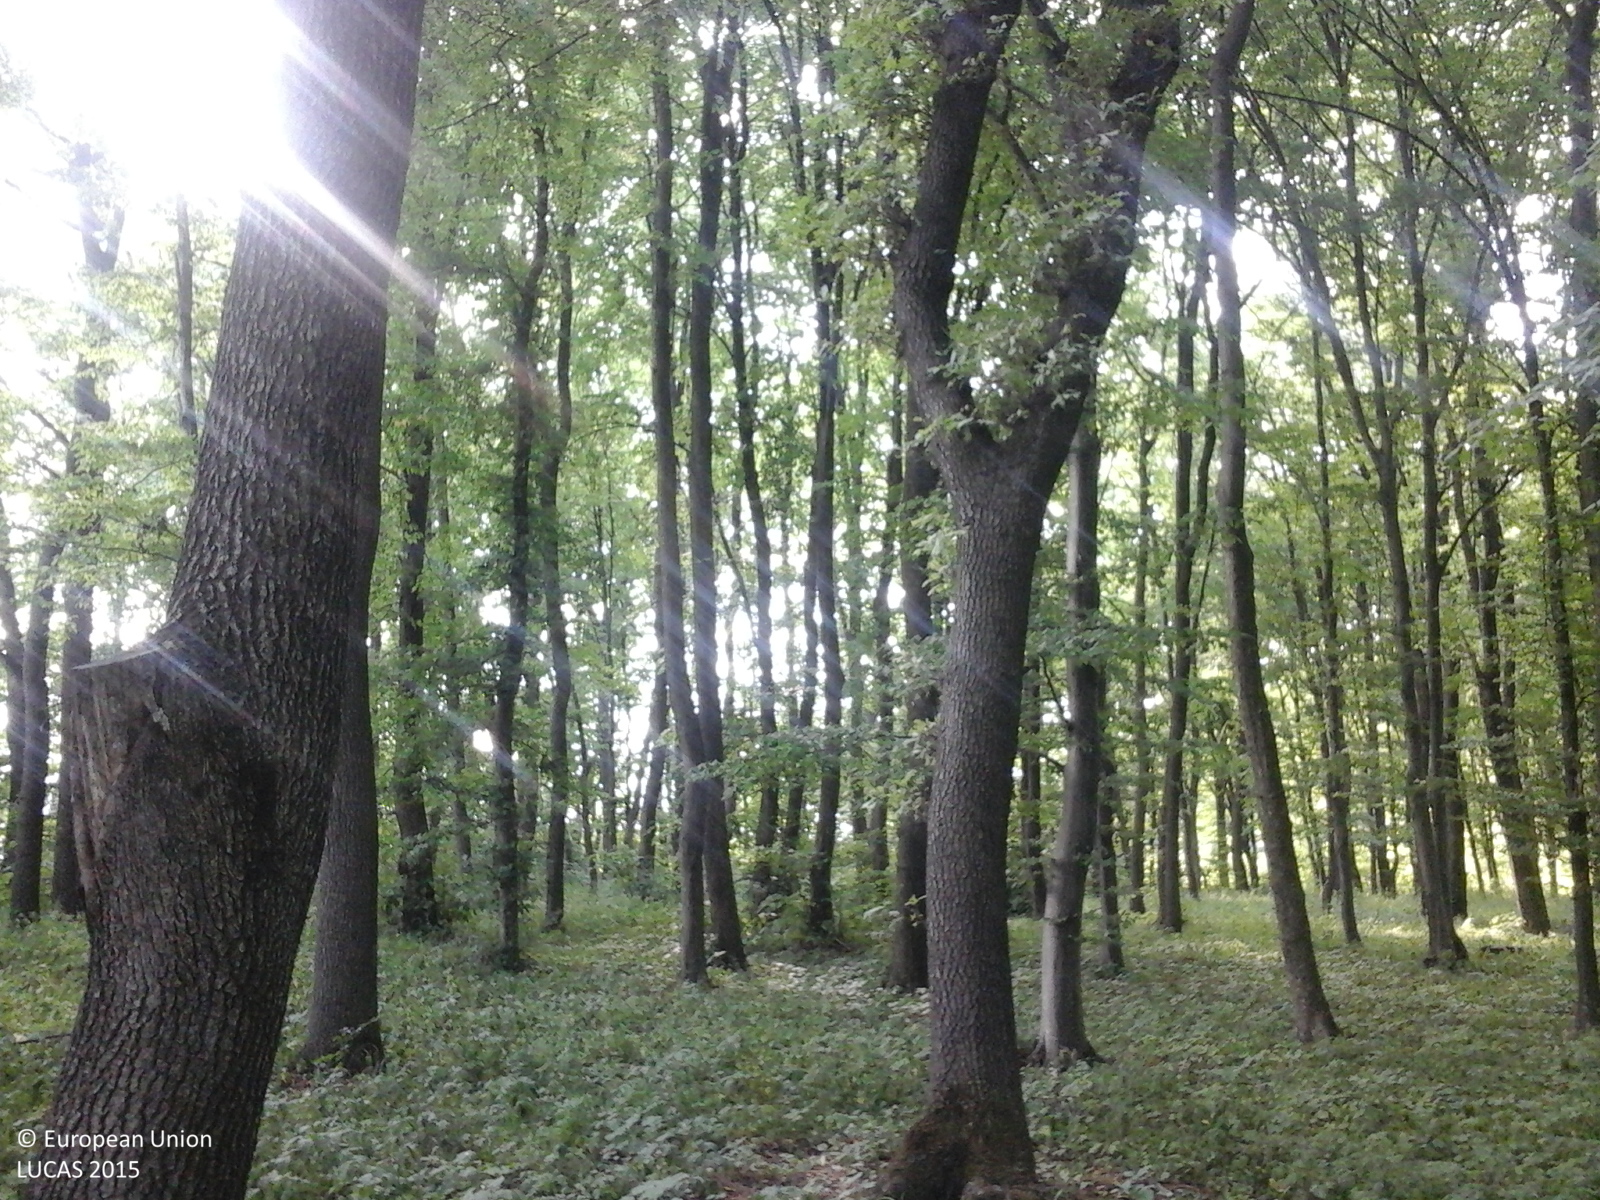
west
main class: Woodland
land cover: Broadleaved woodland
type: beech forest
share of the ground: > 75 %
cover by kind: broadleaved forest trees 90 %, herbaceous plants 10 %
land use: Forestry
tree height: > 5 m
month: June
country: RO
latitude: 47.7104
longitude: 26.3330
